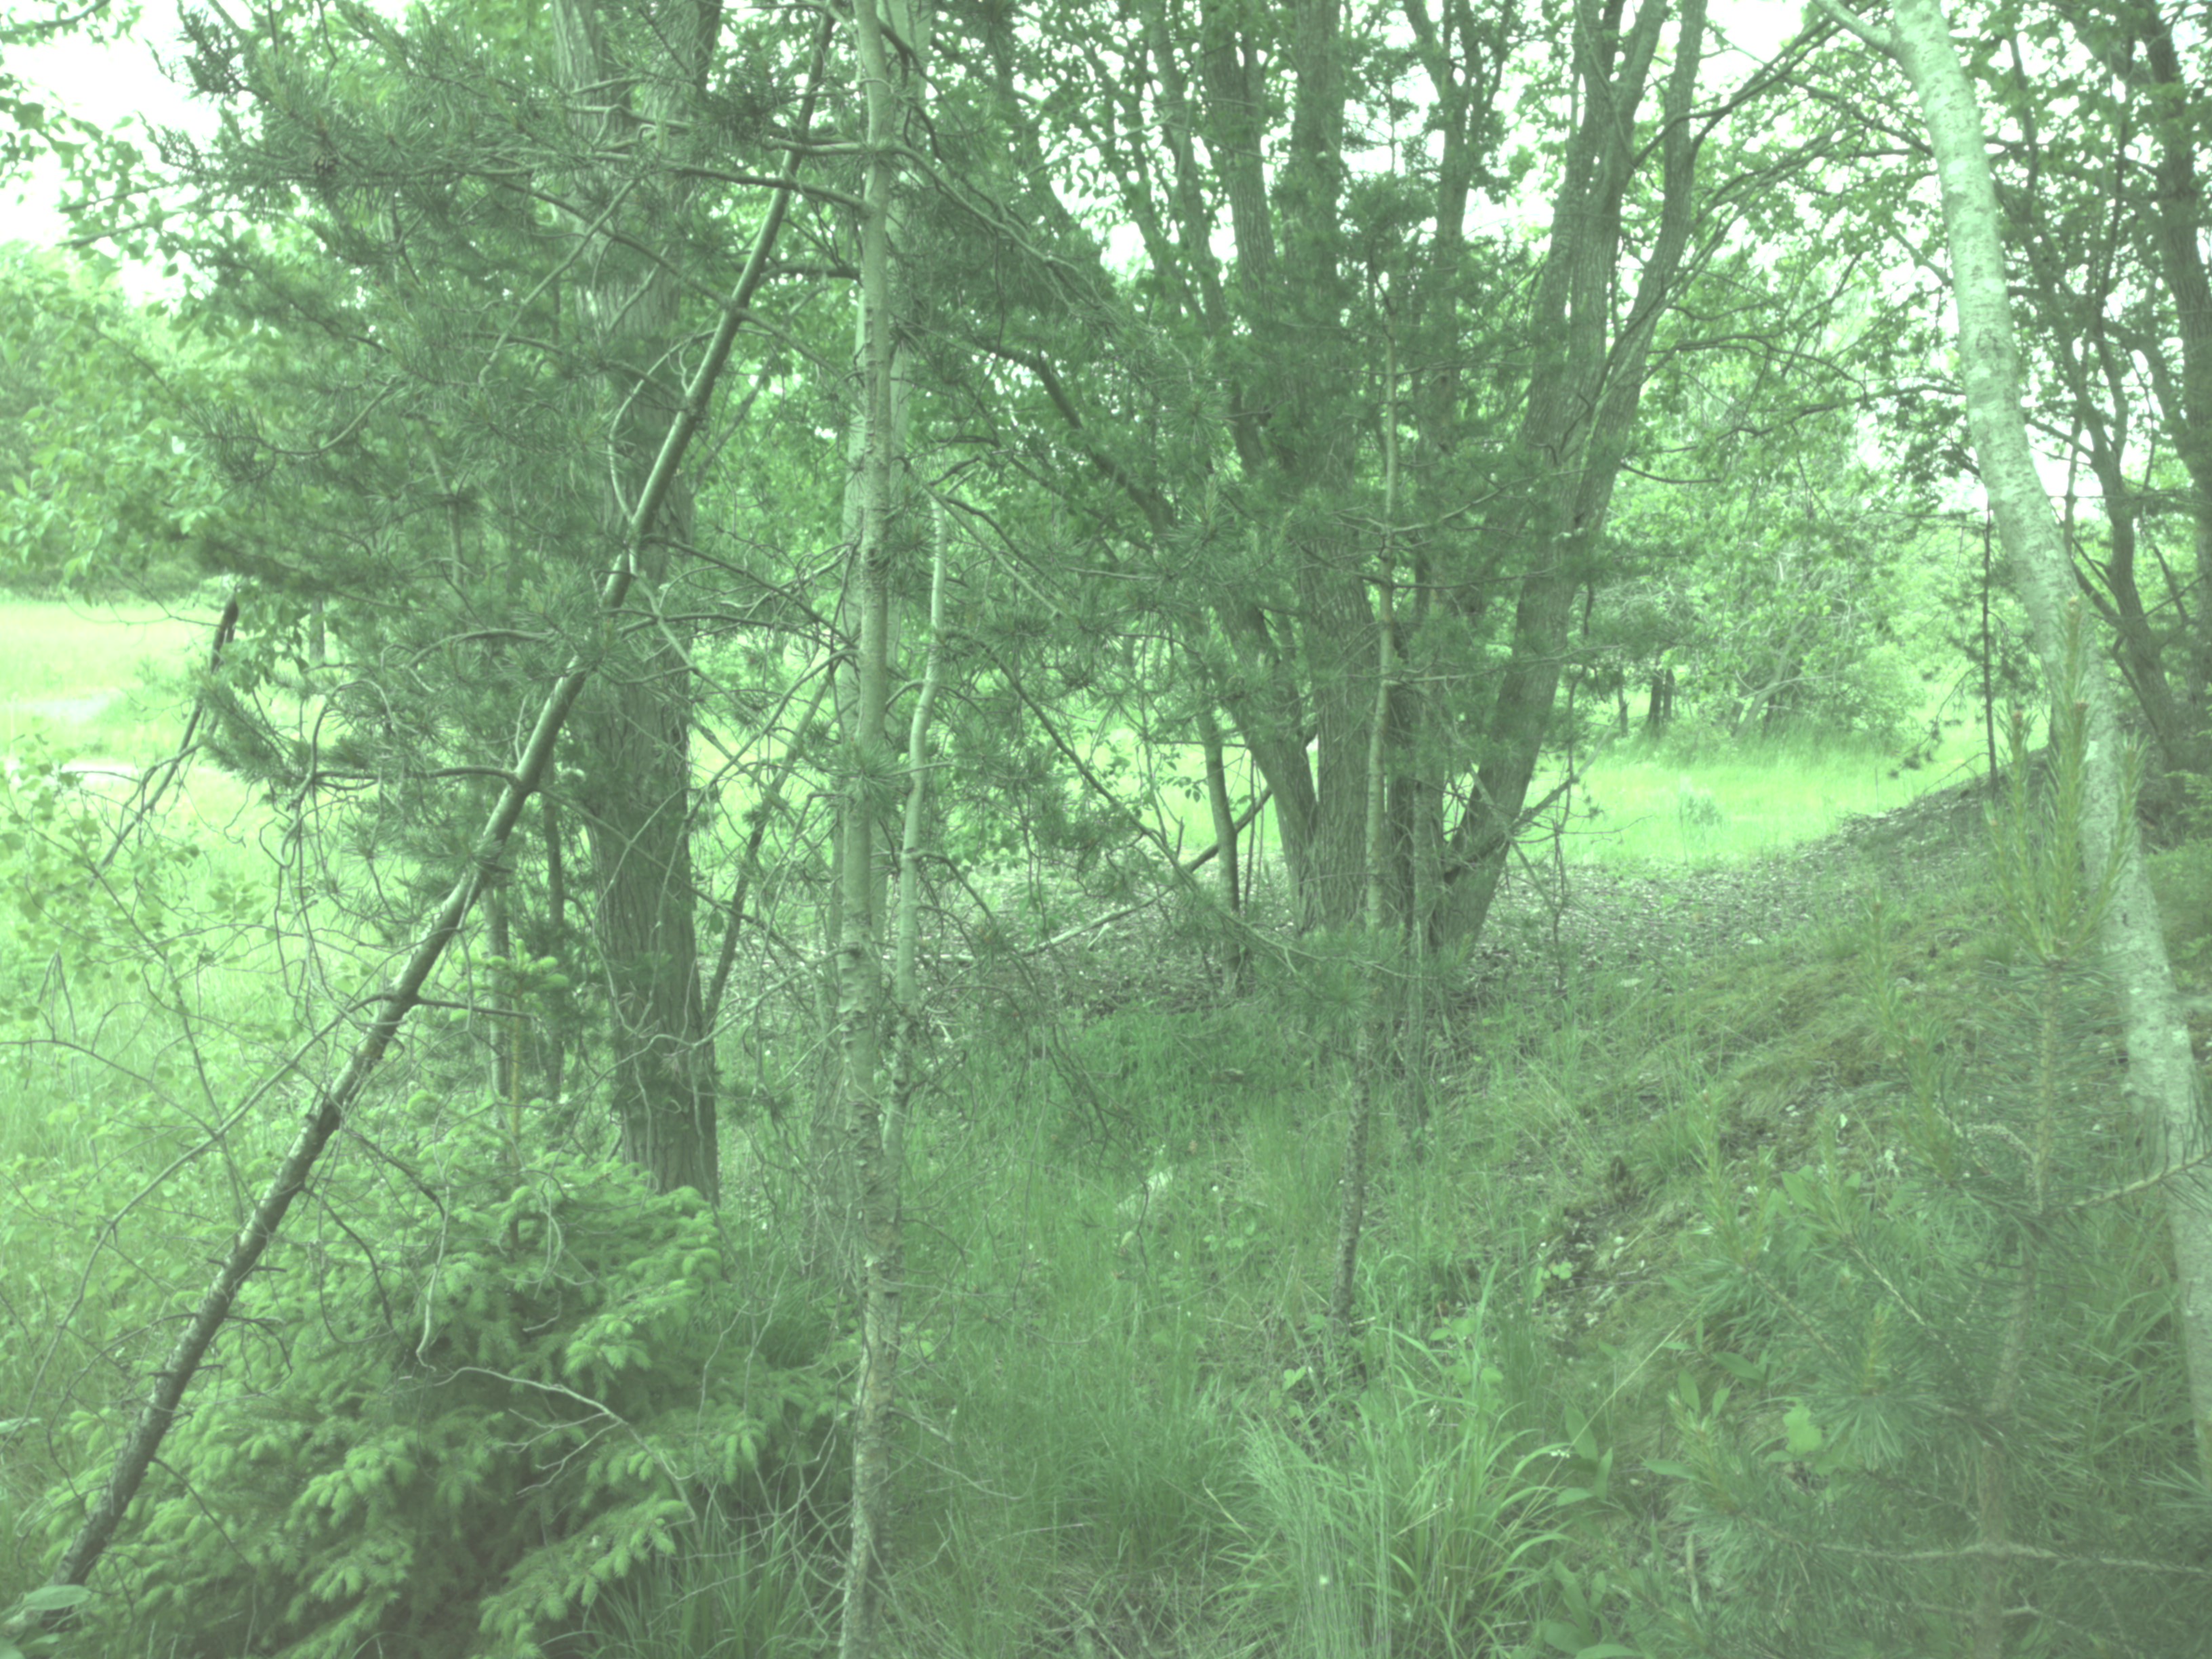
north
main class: Woodland
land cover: Broadleaved woodland
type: non-riverine alder, birch or aspen forest
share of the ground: > 75 %
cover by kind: broadleaved forest trees 60 %, coniferous forest trees 20 %, shrubs 10 %, herbaceous plants 10 %
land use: Forestry
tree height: > 5 m
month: June
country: SE
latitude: 59.3059
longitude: 18.2369
